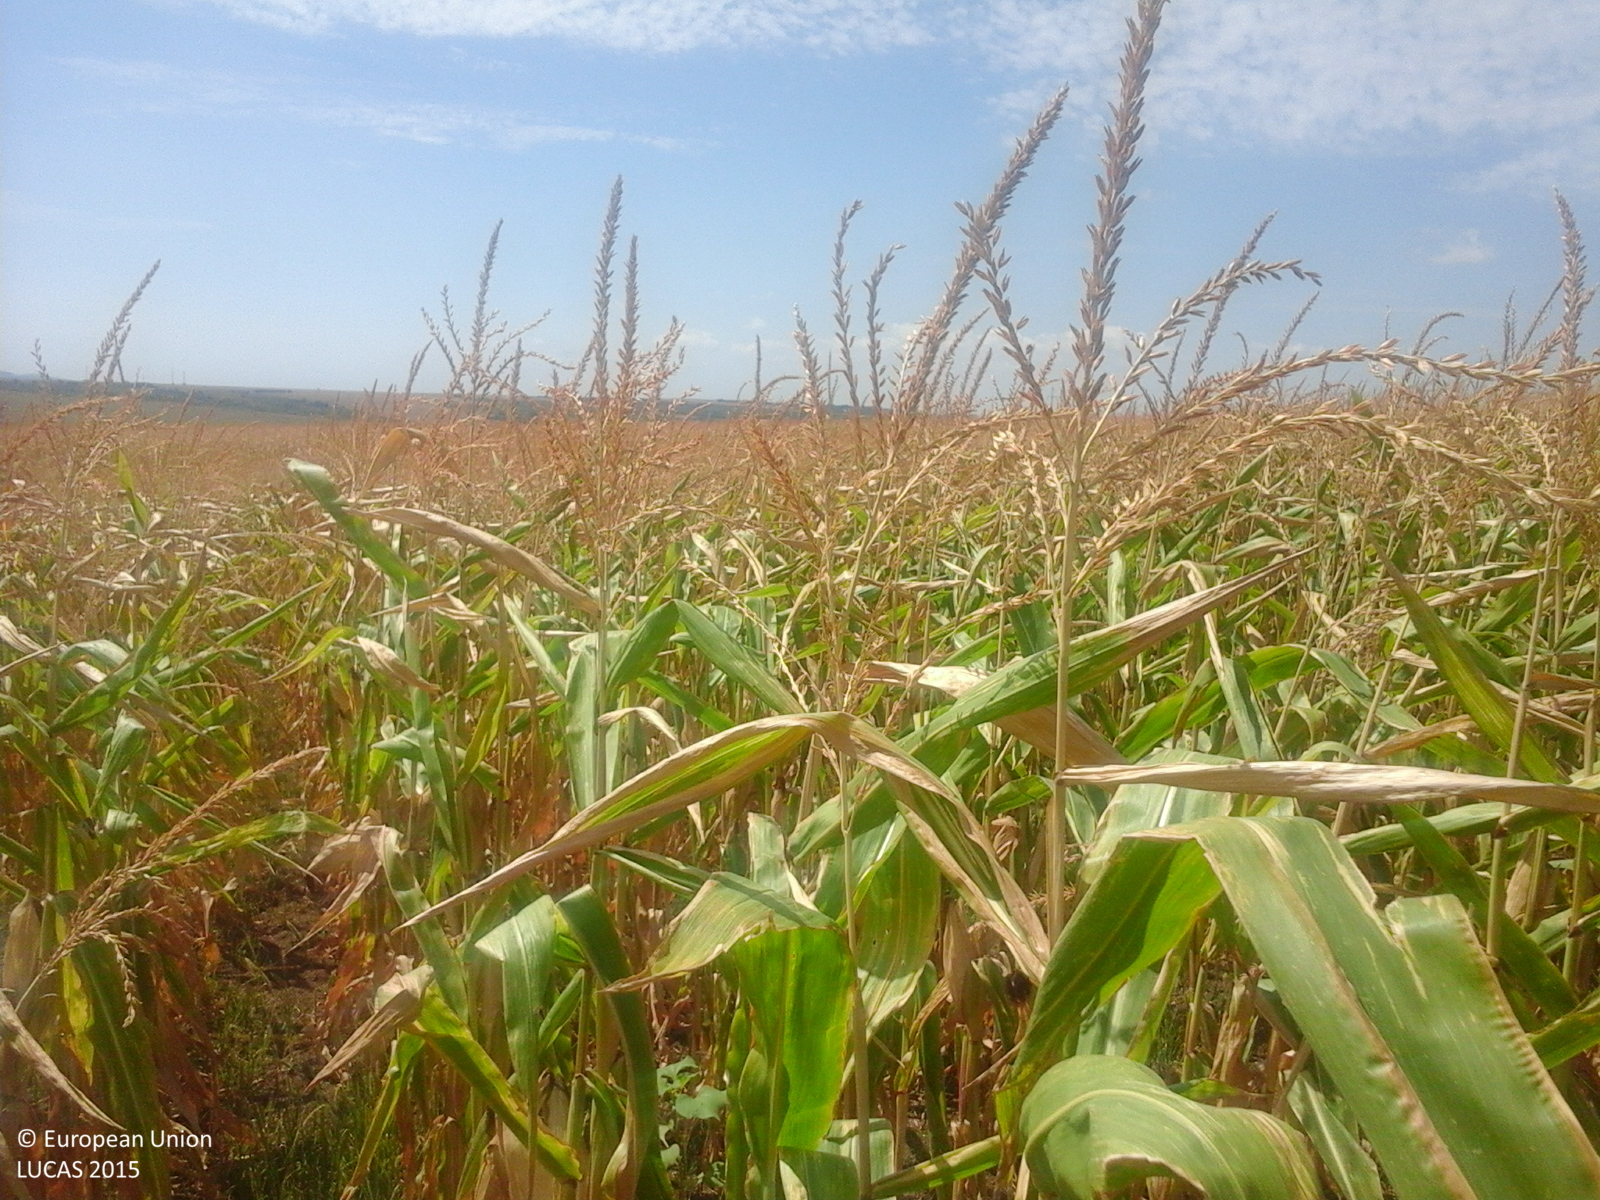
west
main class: Cropland
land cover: Maize
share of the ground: > 75 %
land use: Agriculture (excluding fallow land and kitchen gardens)
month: August
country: RO
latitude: 44.9477
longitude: 21.6530
